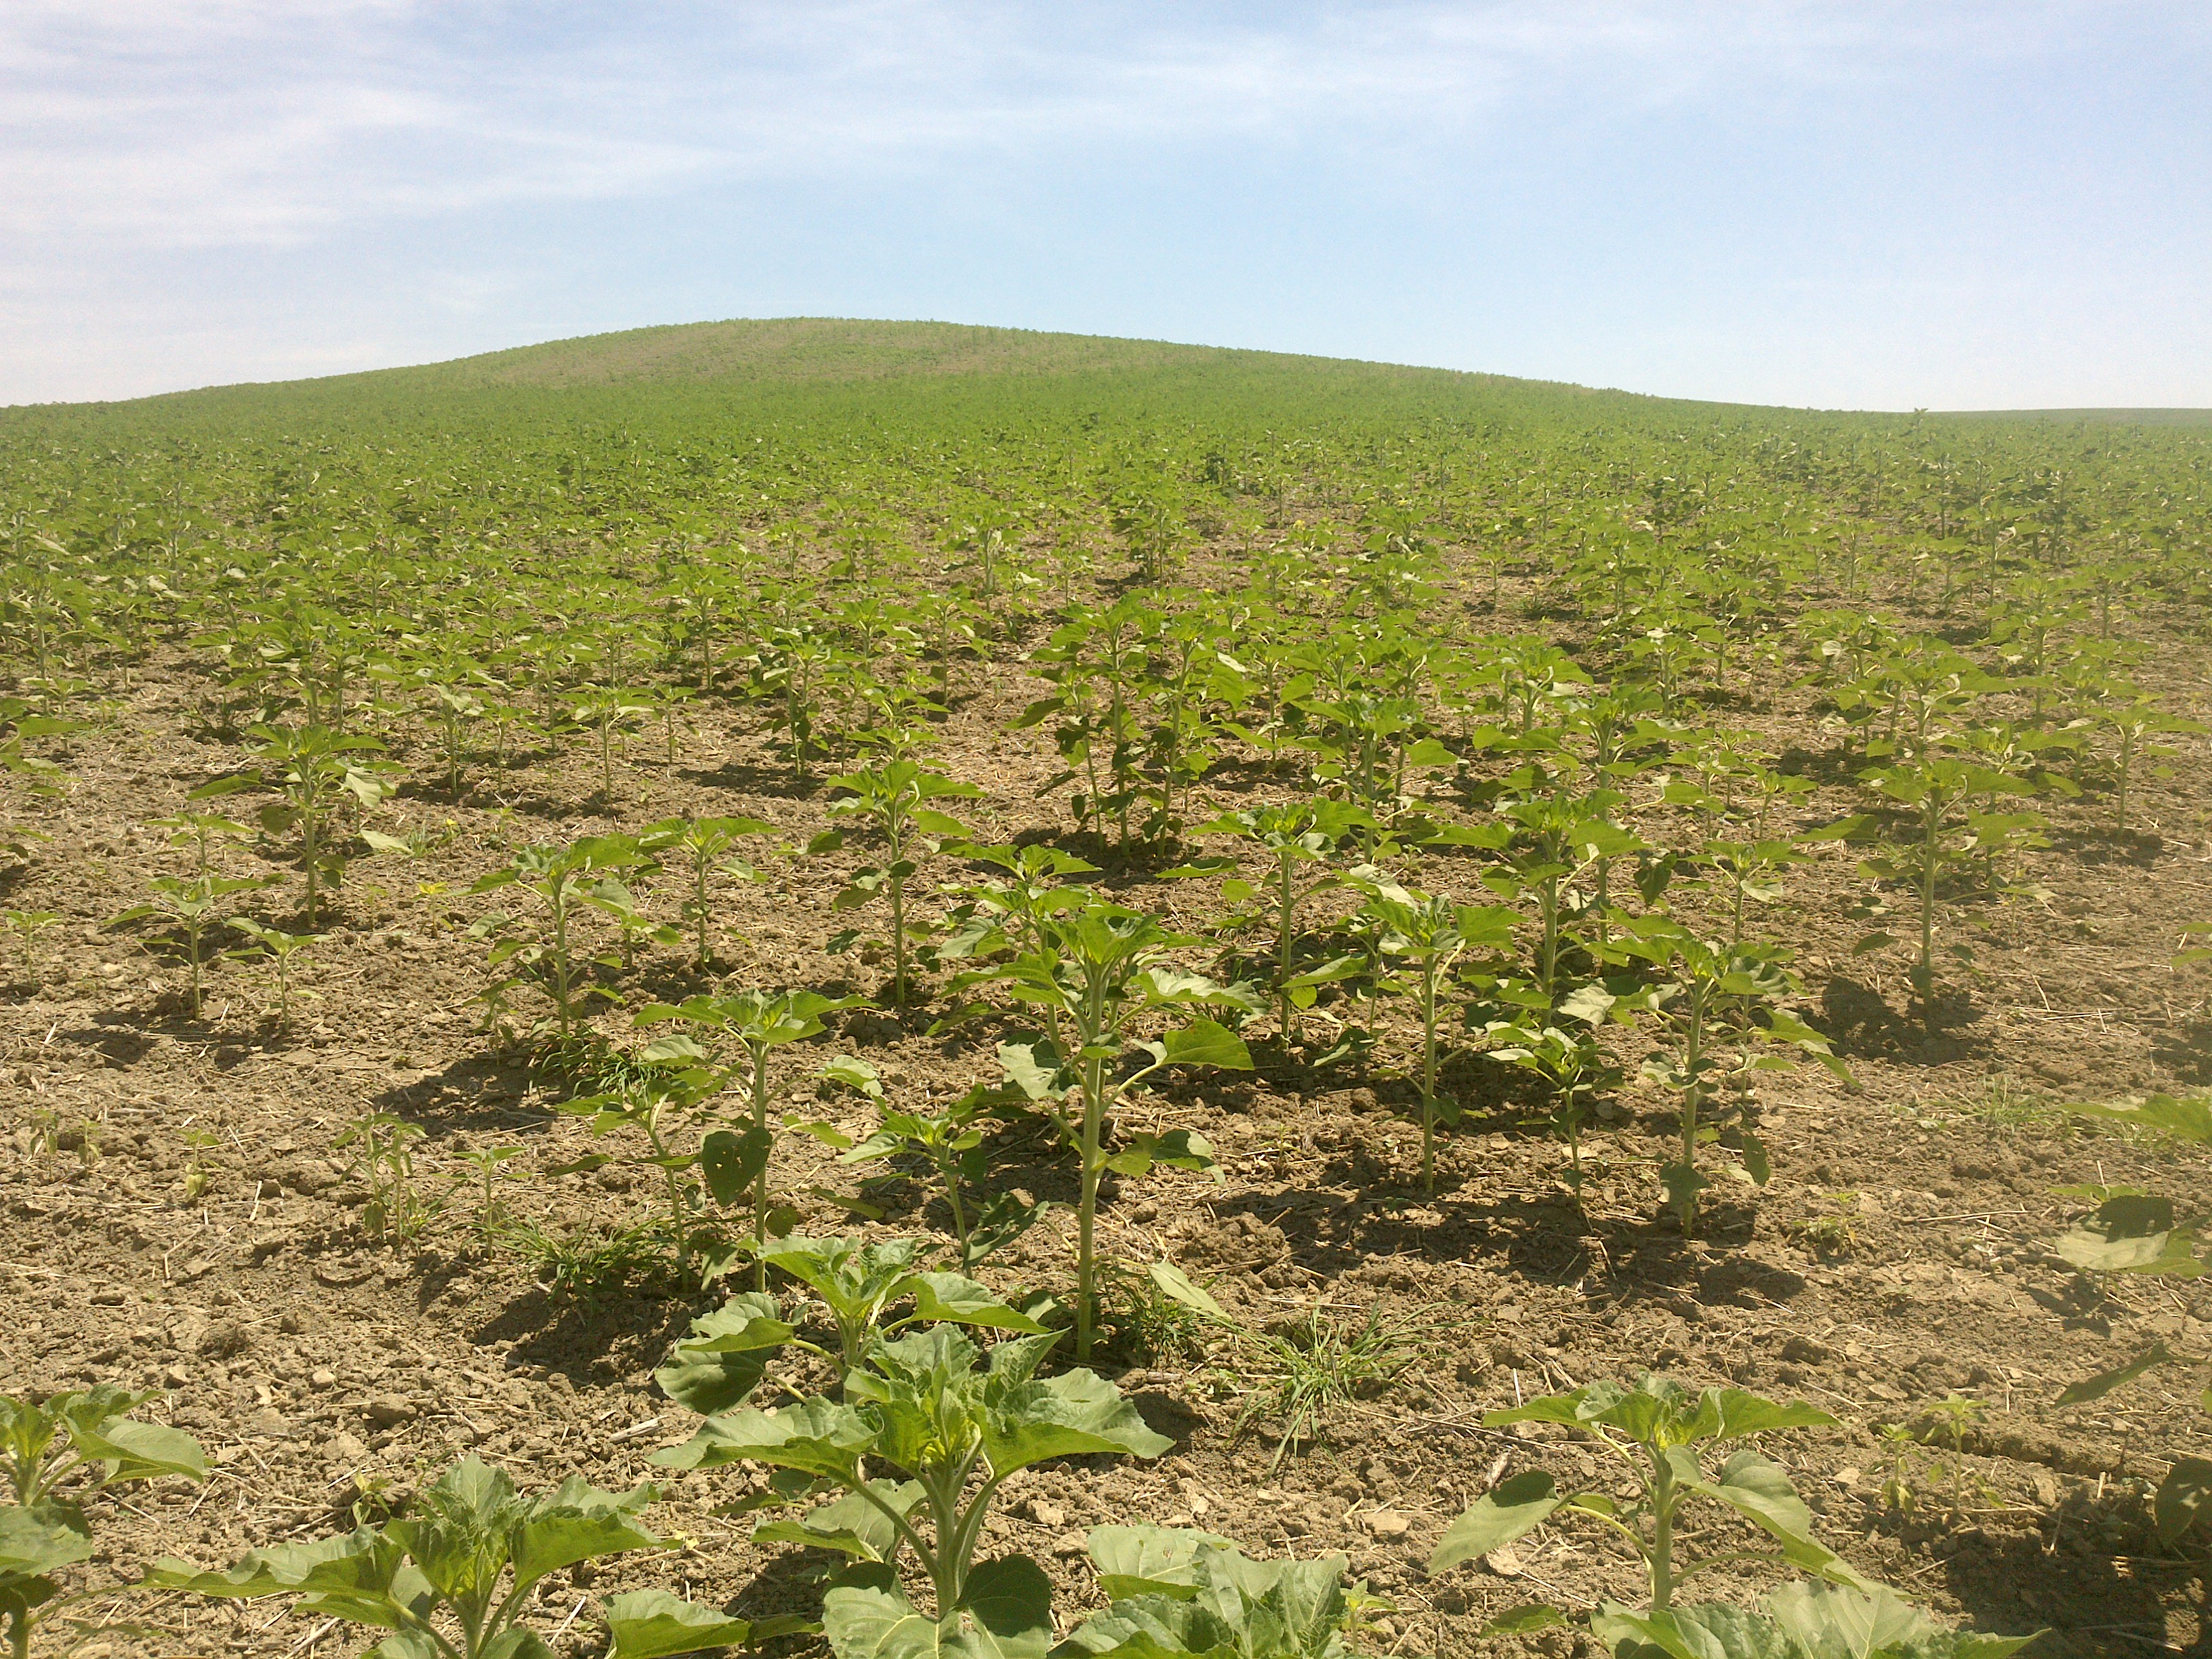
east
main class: Cropland
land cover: Sunflower
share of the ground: > 75 %
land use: Agriculture (excluding fallow land and kitchen gardens)
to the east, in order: Sunflower
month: May
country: ES
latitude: 37.8548
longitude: -4.6625
